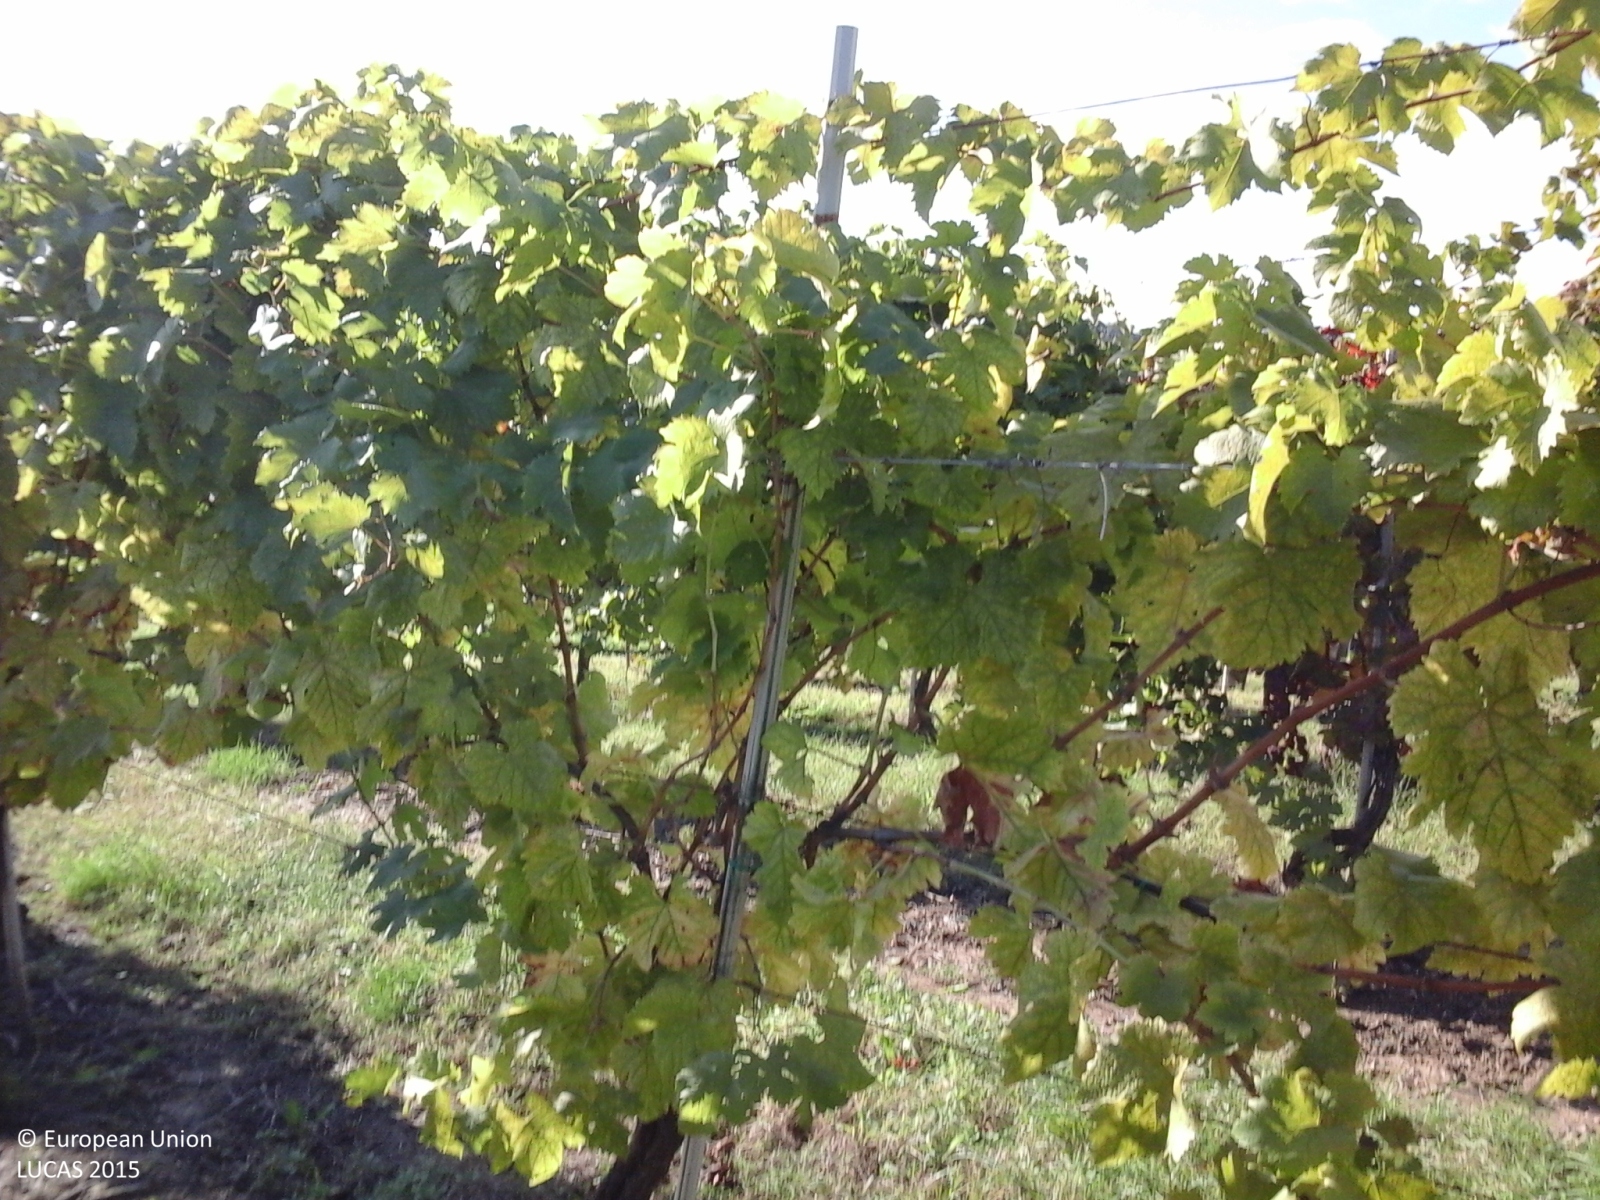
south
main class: Cropland
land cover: Vineyards
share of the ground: 50 - 75 %
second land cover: Grassland without tree/shrub cover
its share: > 75 %
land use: Agriculture (excluding fallow land and kitchen gardens)
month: October
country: IT
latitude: 43.6692
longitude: 13.2045
